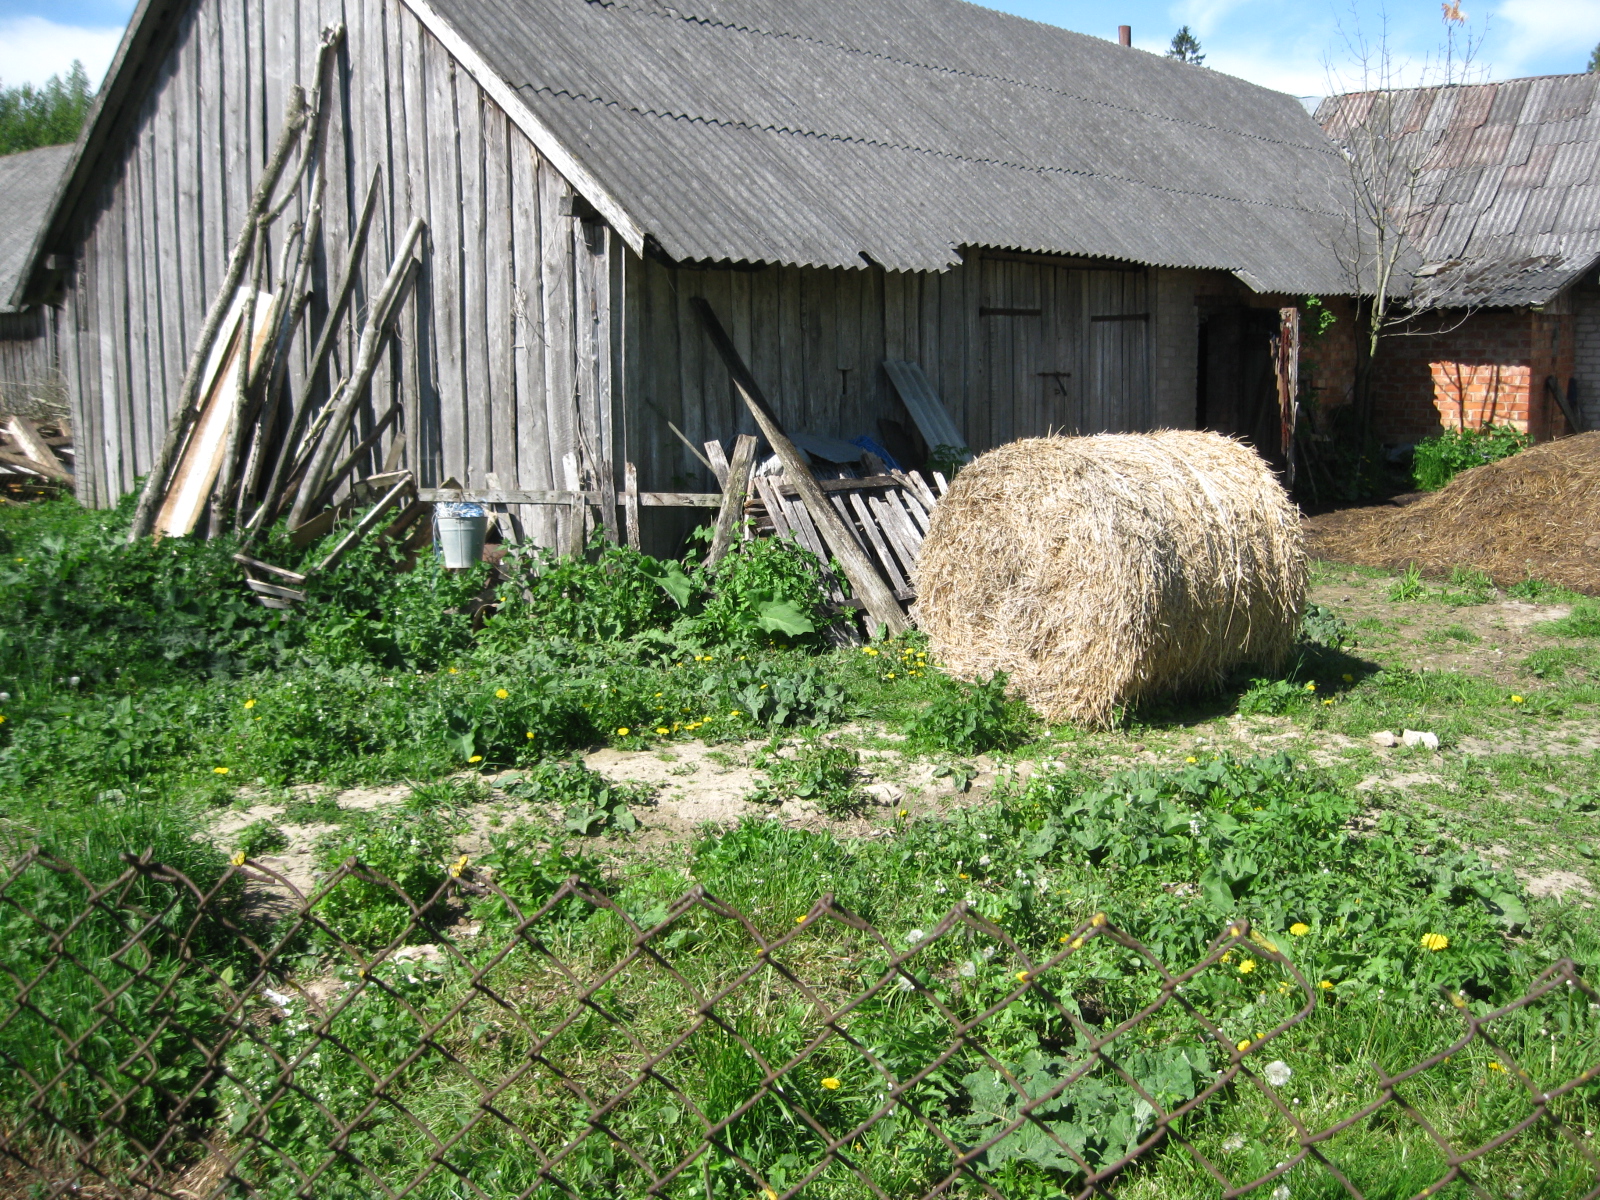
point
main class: Grassland
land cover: Spontaneously vegetated surfaces
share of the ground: 50 - 75 %
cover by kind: herbaceous plants 60 %, unconsolidated bare surface 40 %
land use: Residential
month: May
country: LT
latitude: 56.1207
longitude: 24.0660
